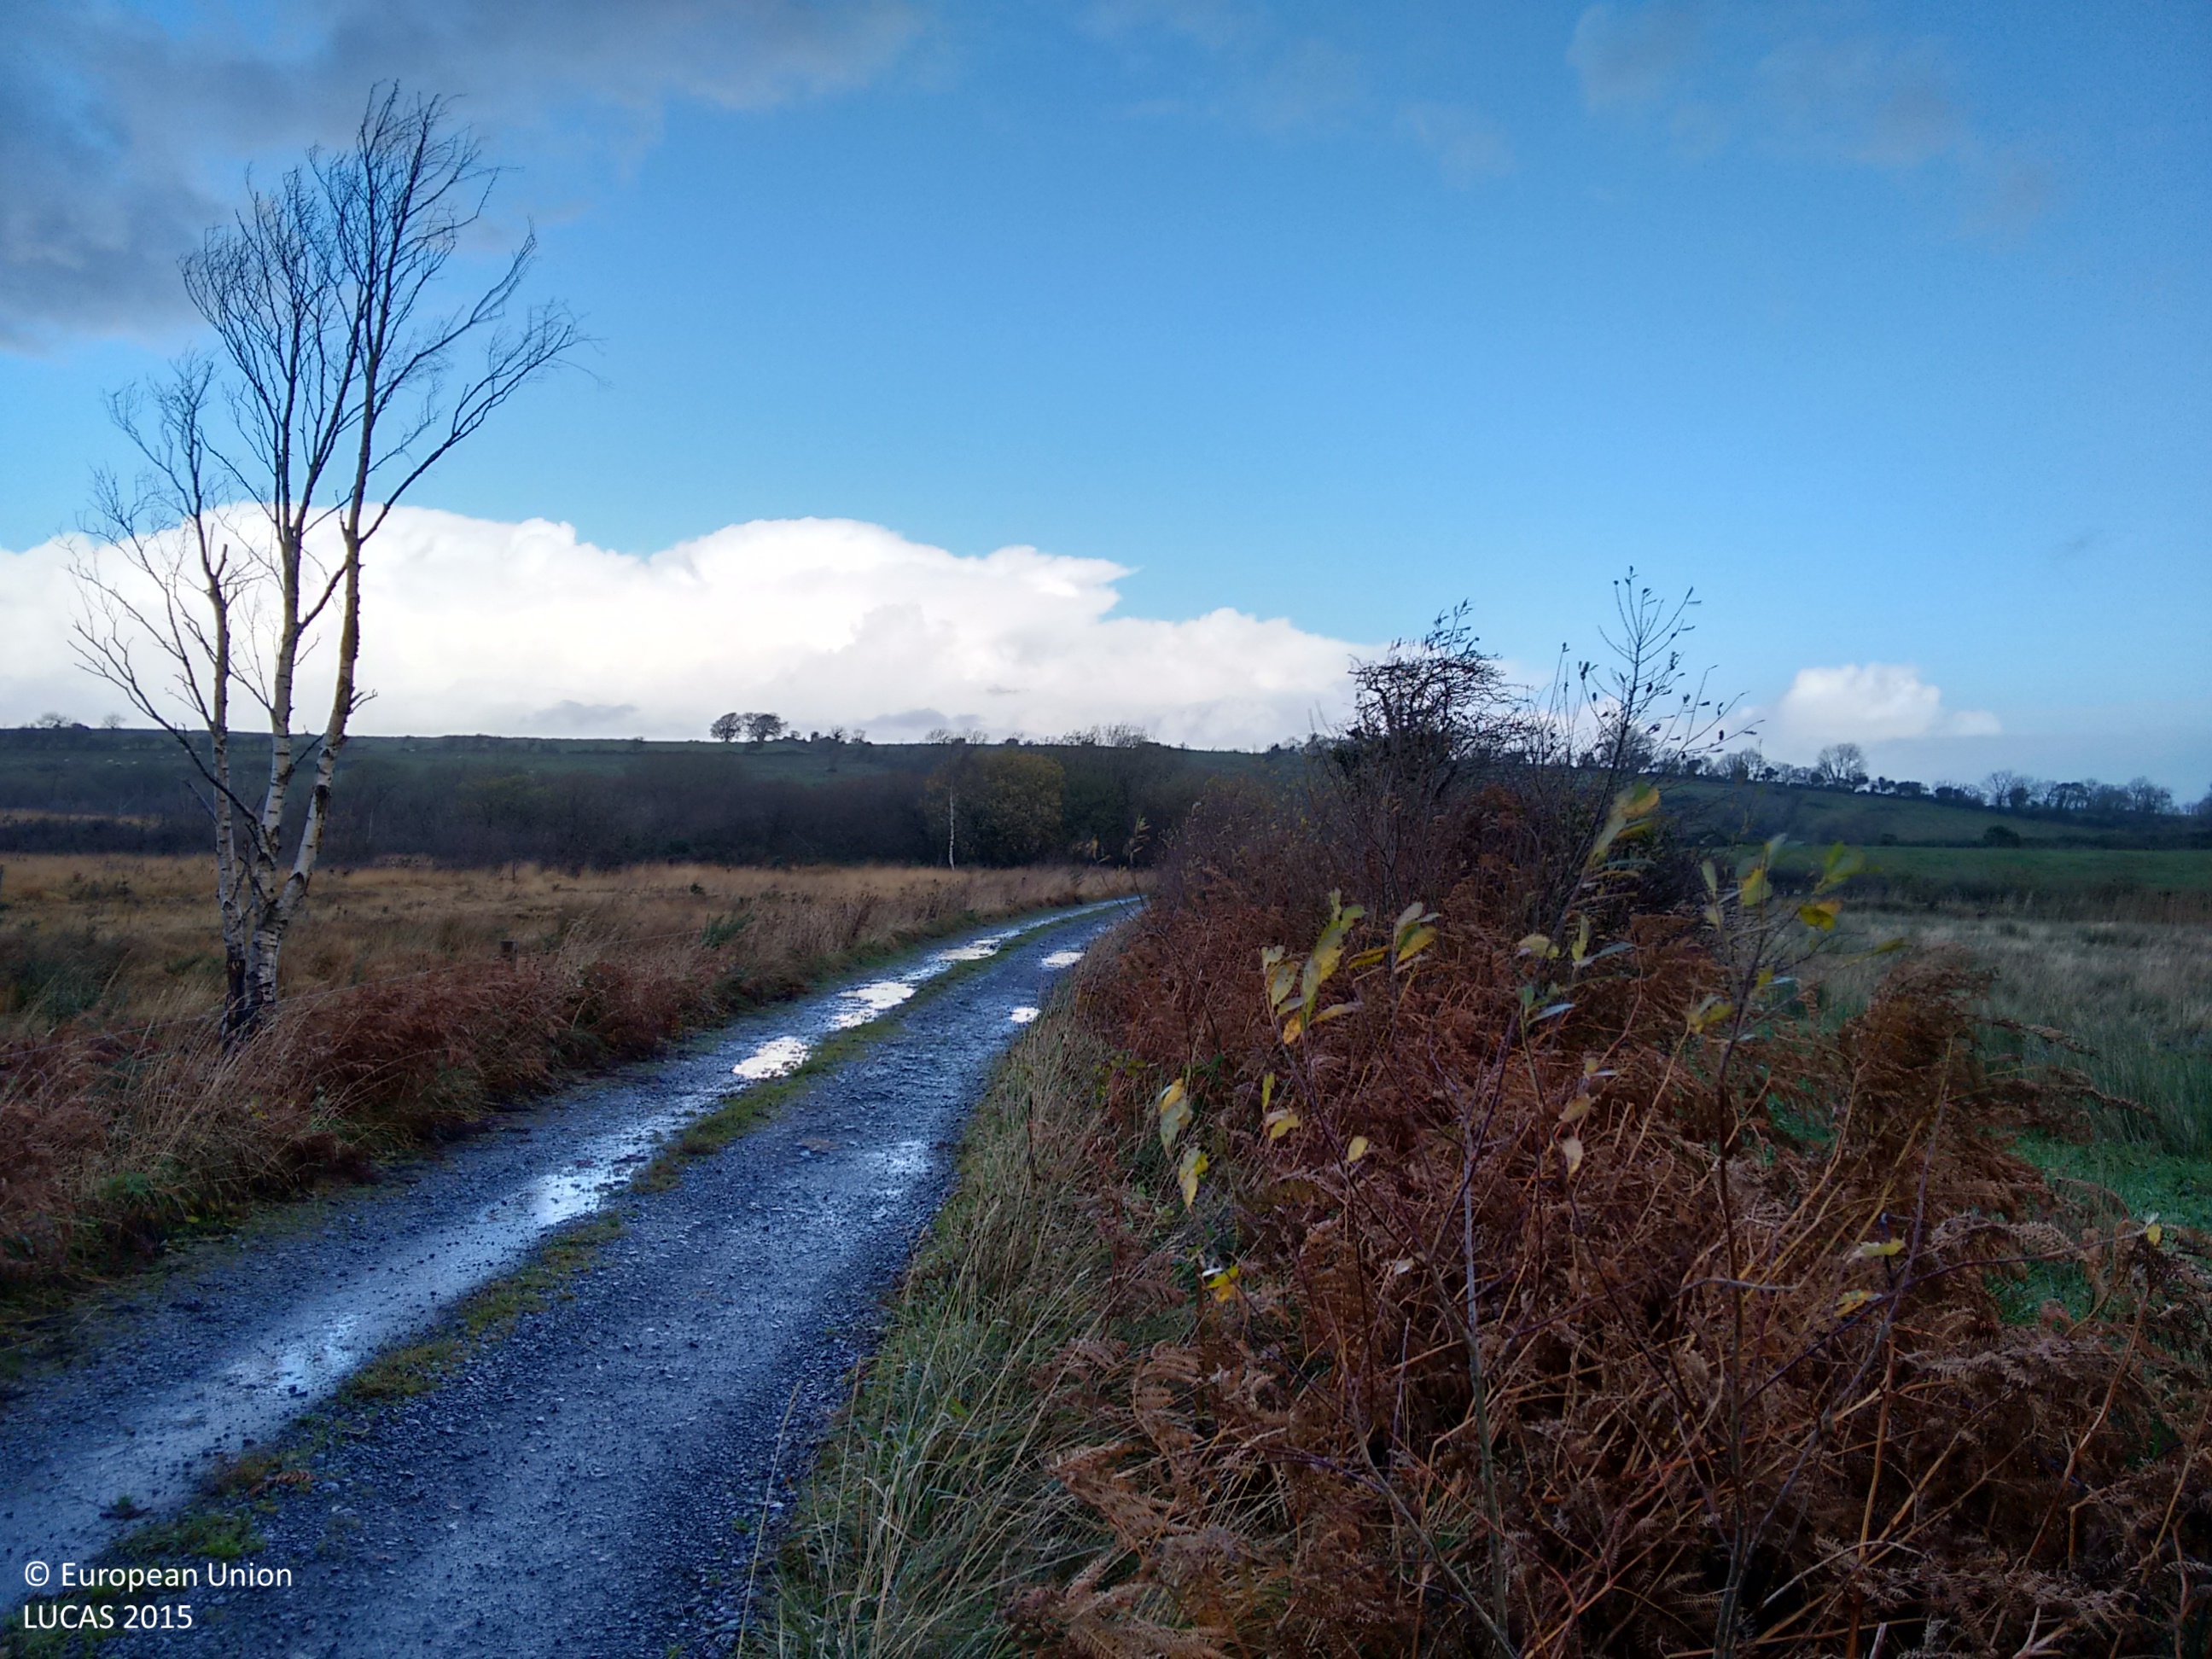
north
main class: Grassland
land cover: Grassland without tree/shrub cover
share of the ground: > 75 %
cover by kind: herbaceous plants 100 %
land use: Agriculture (excluding fallow land and kitchen gardens)
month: November
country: IE
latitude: 54.4732
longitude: -8.1240
